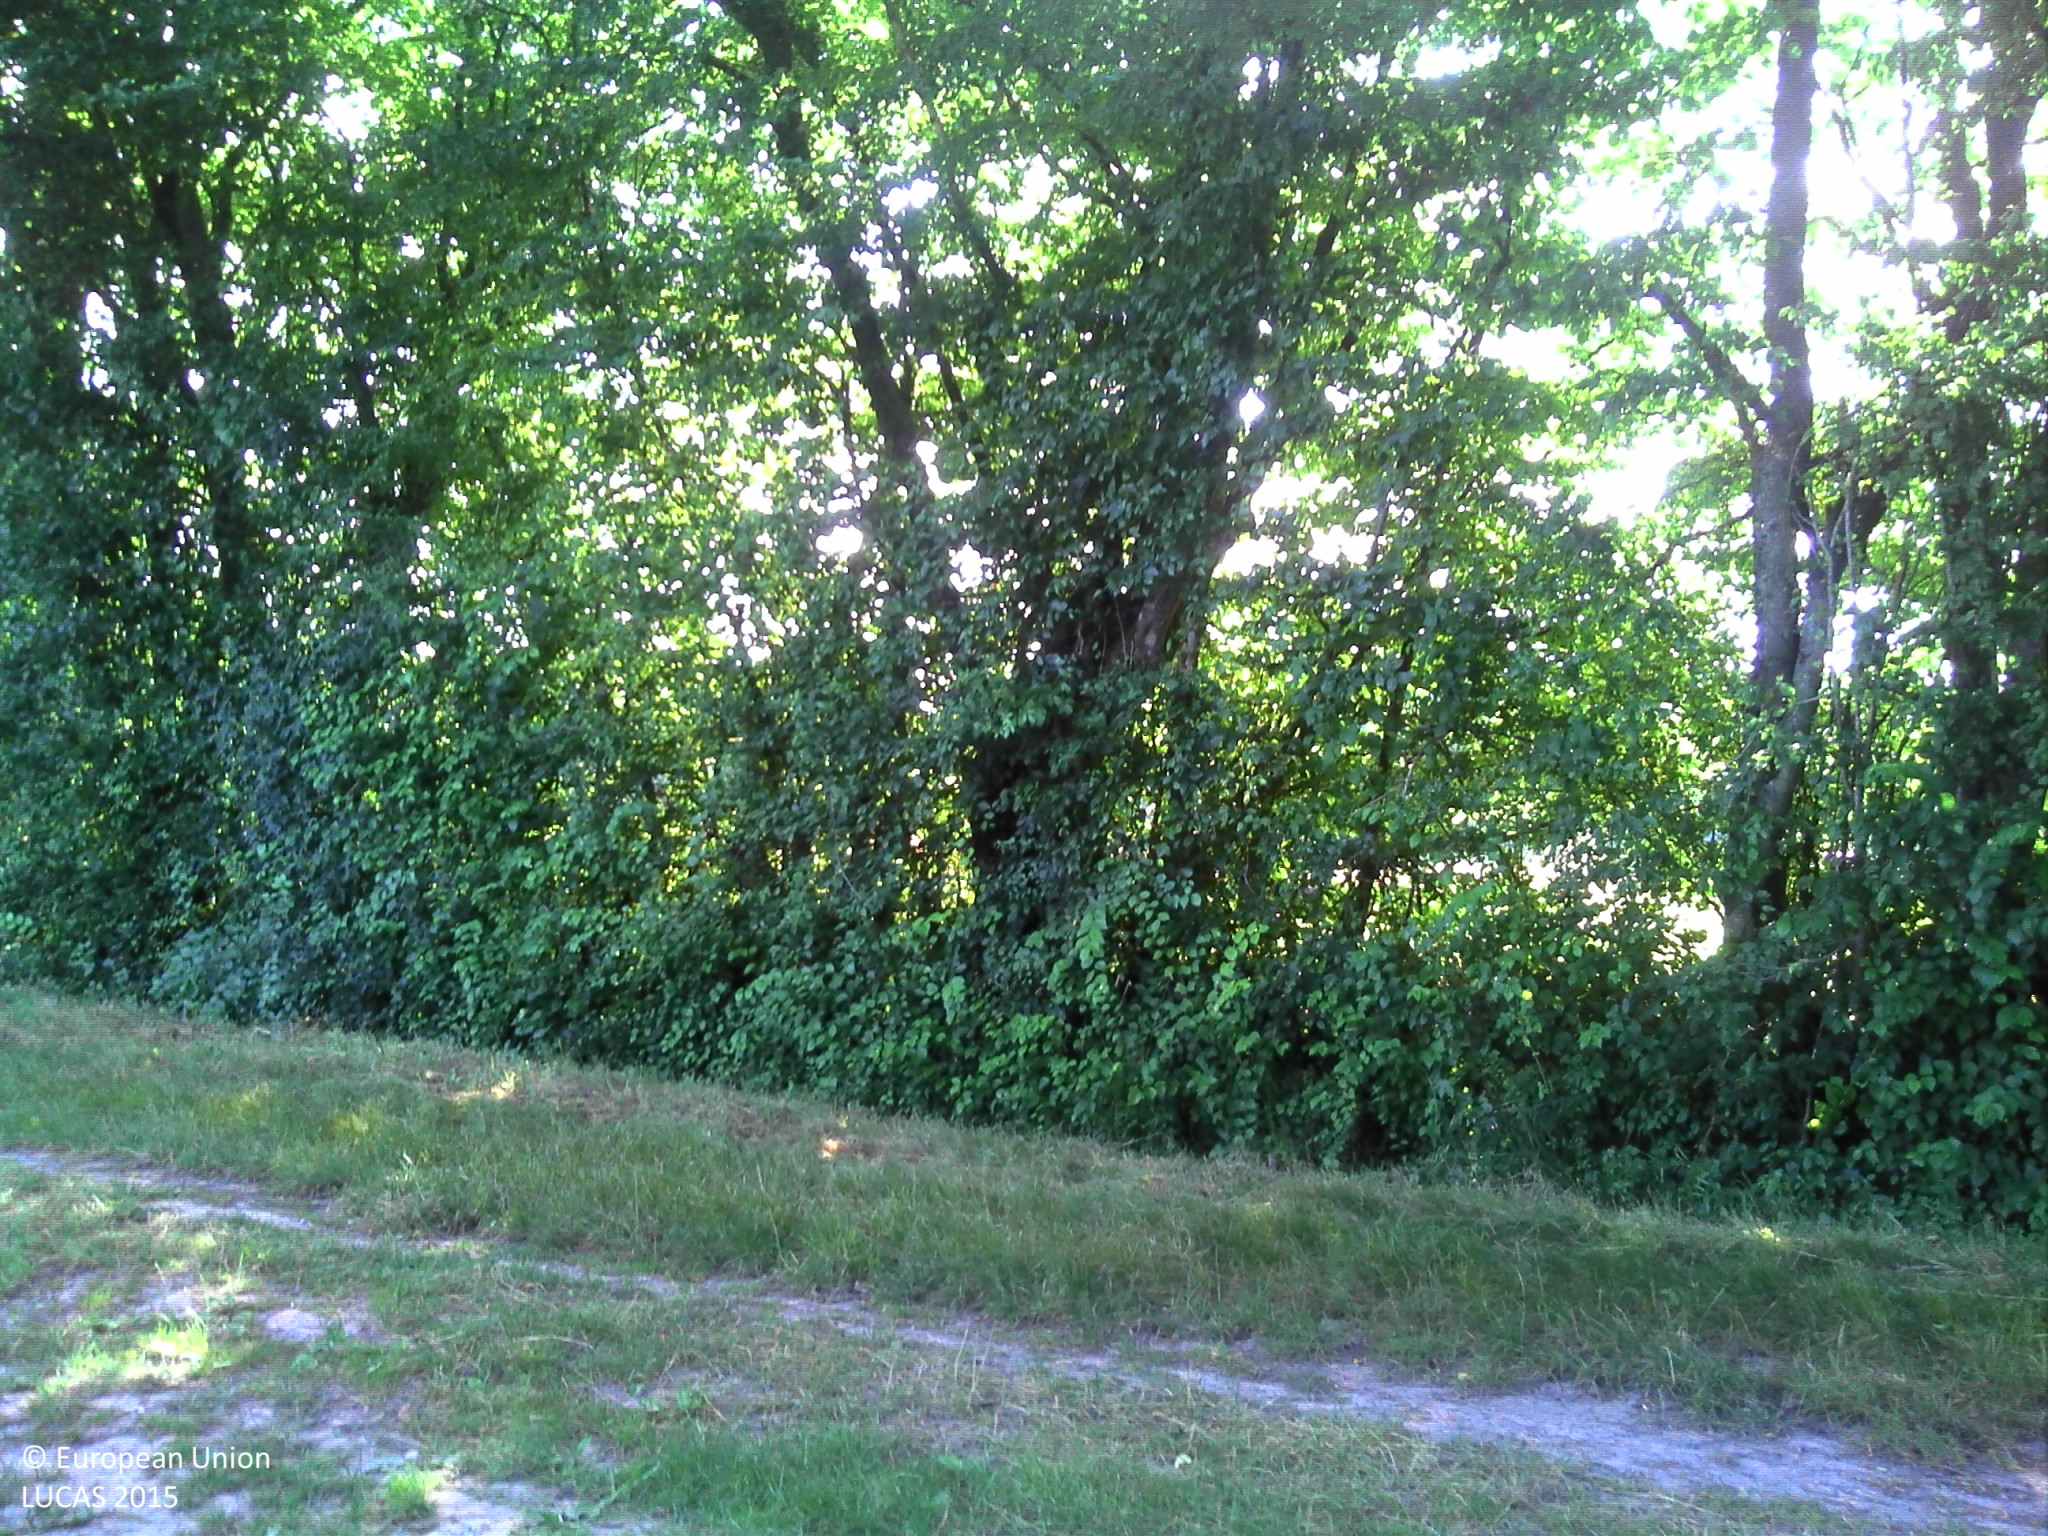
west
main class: Cropland
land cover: Sunflower
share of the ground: 25 - 50 %
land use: Agriculture (excluding fallow land and kitchen gardens)
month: June
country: FR
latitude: 47.6335
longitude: 2.6324
